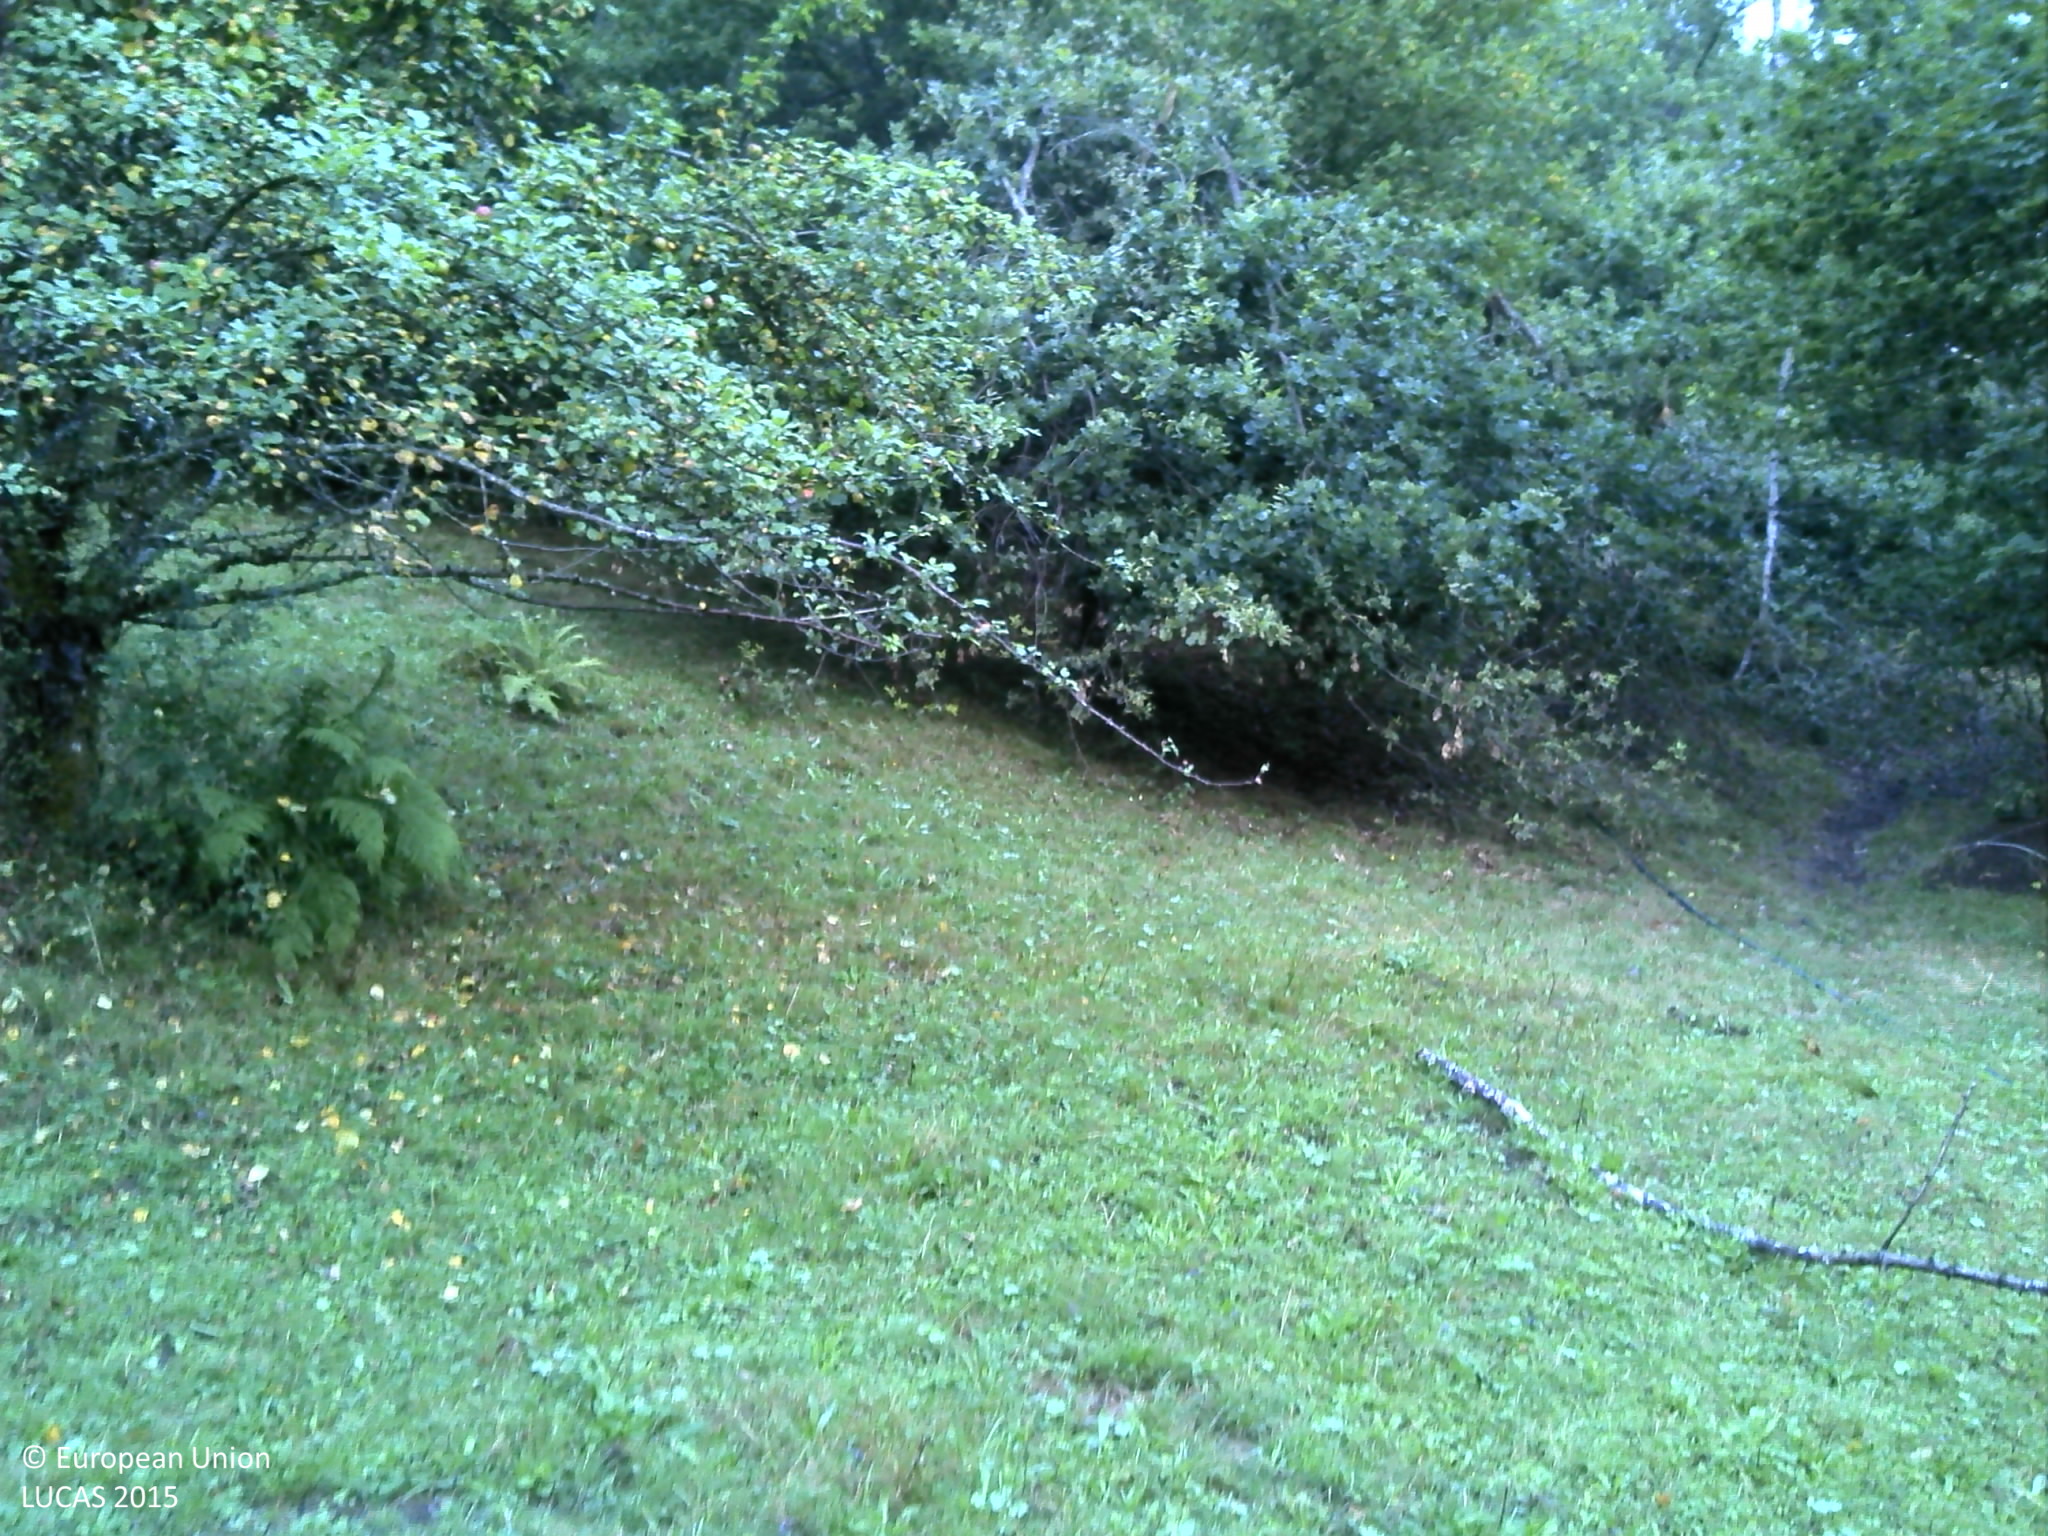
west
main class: Grassland
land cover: Grassland with sparse tree/shrub cover
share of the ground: > 75 %
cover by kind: herbaceous plants 95 %, broadleaved forest trees 5 %
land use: Agriculture (excluding fallow land and kitchen gardens)
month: August
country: FR
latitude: 47.8539
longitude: 6.8338
